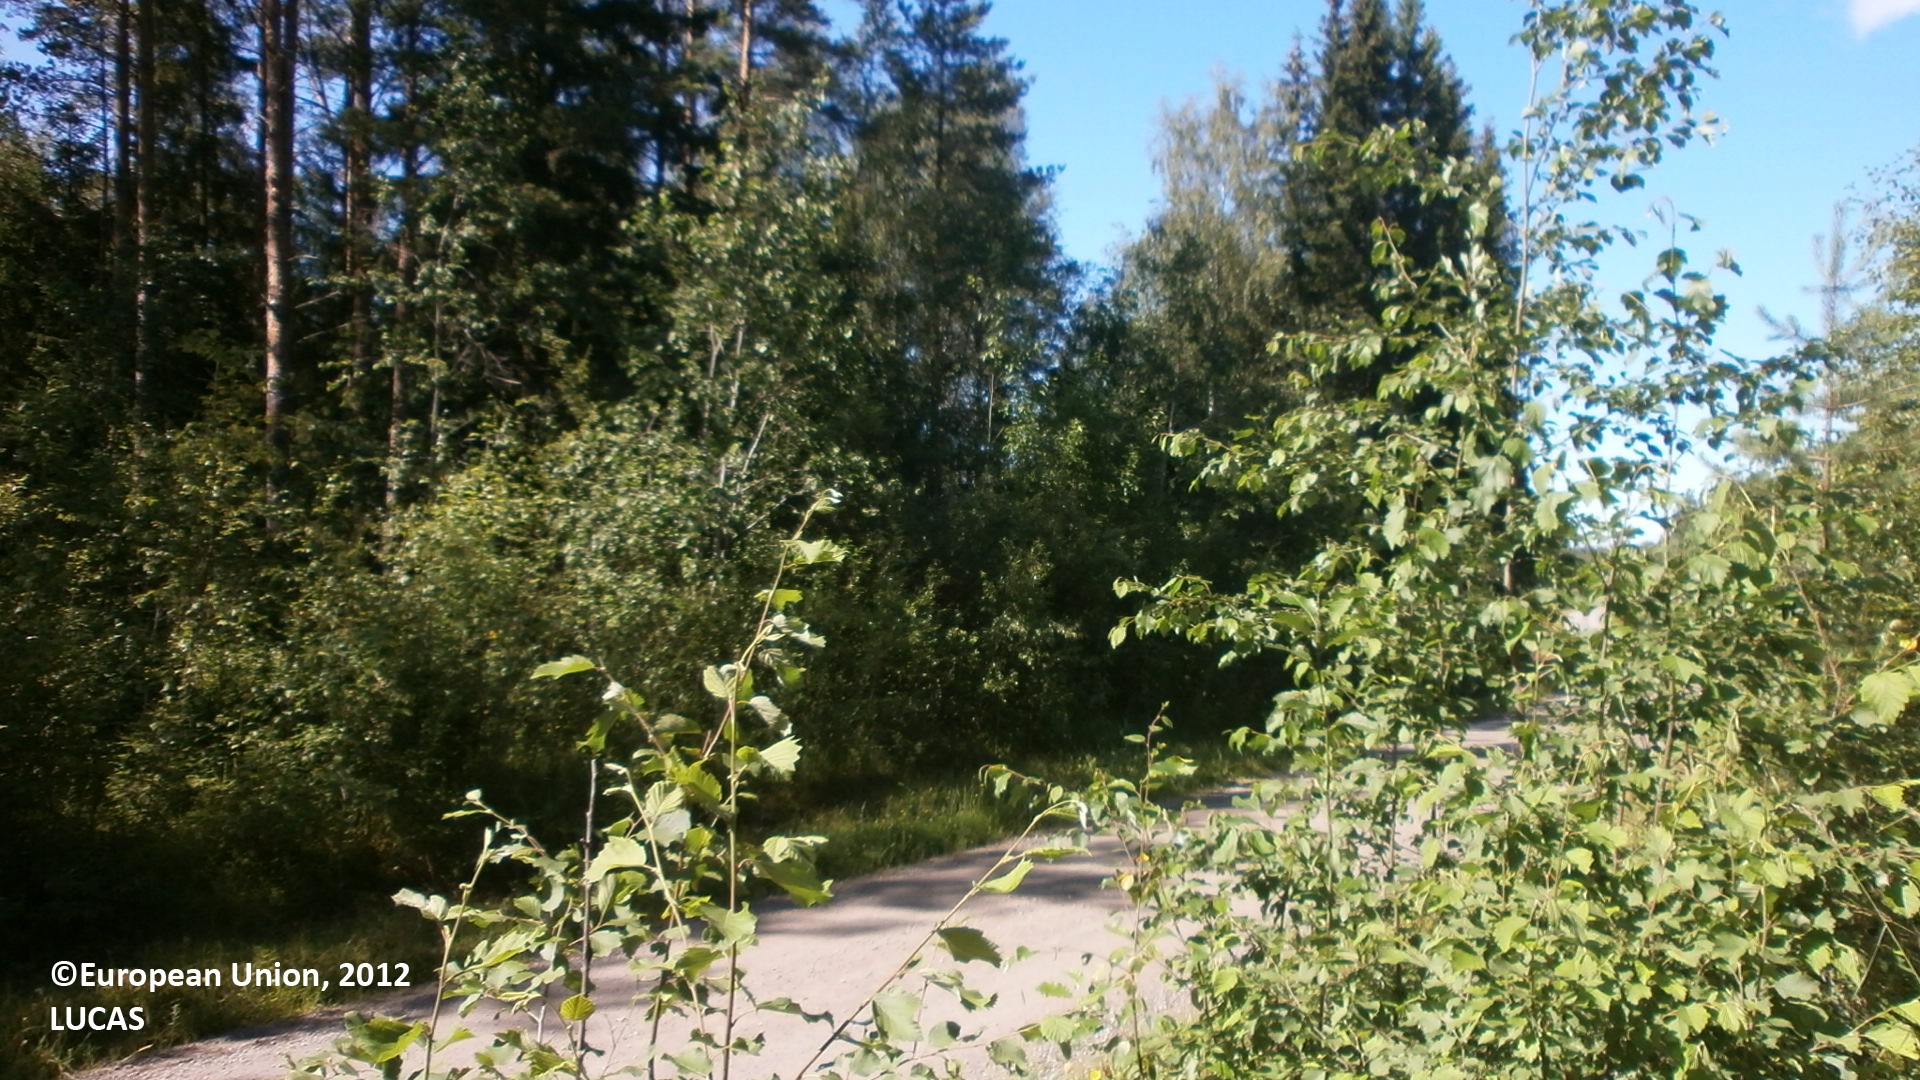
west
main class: Woodland
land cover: Pine dominated coniferous woodland
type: boreal forest
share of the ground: 50 - 75 %
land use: Forestry
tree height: > 5 m
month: July
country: FI
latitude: 64.1110
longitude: 24.3368
